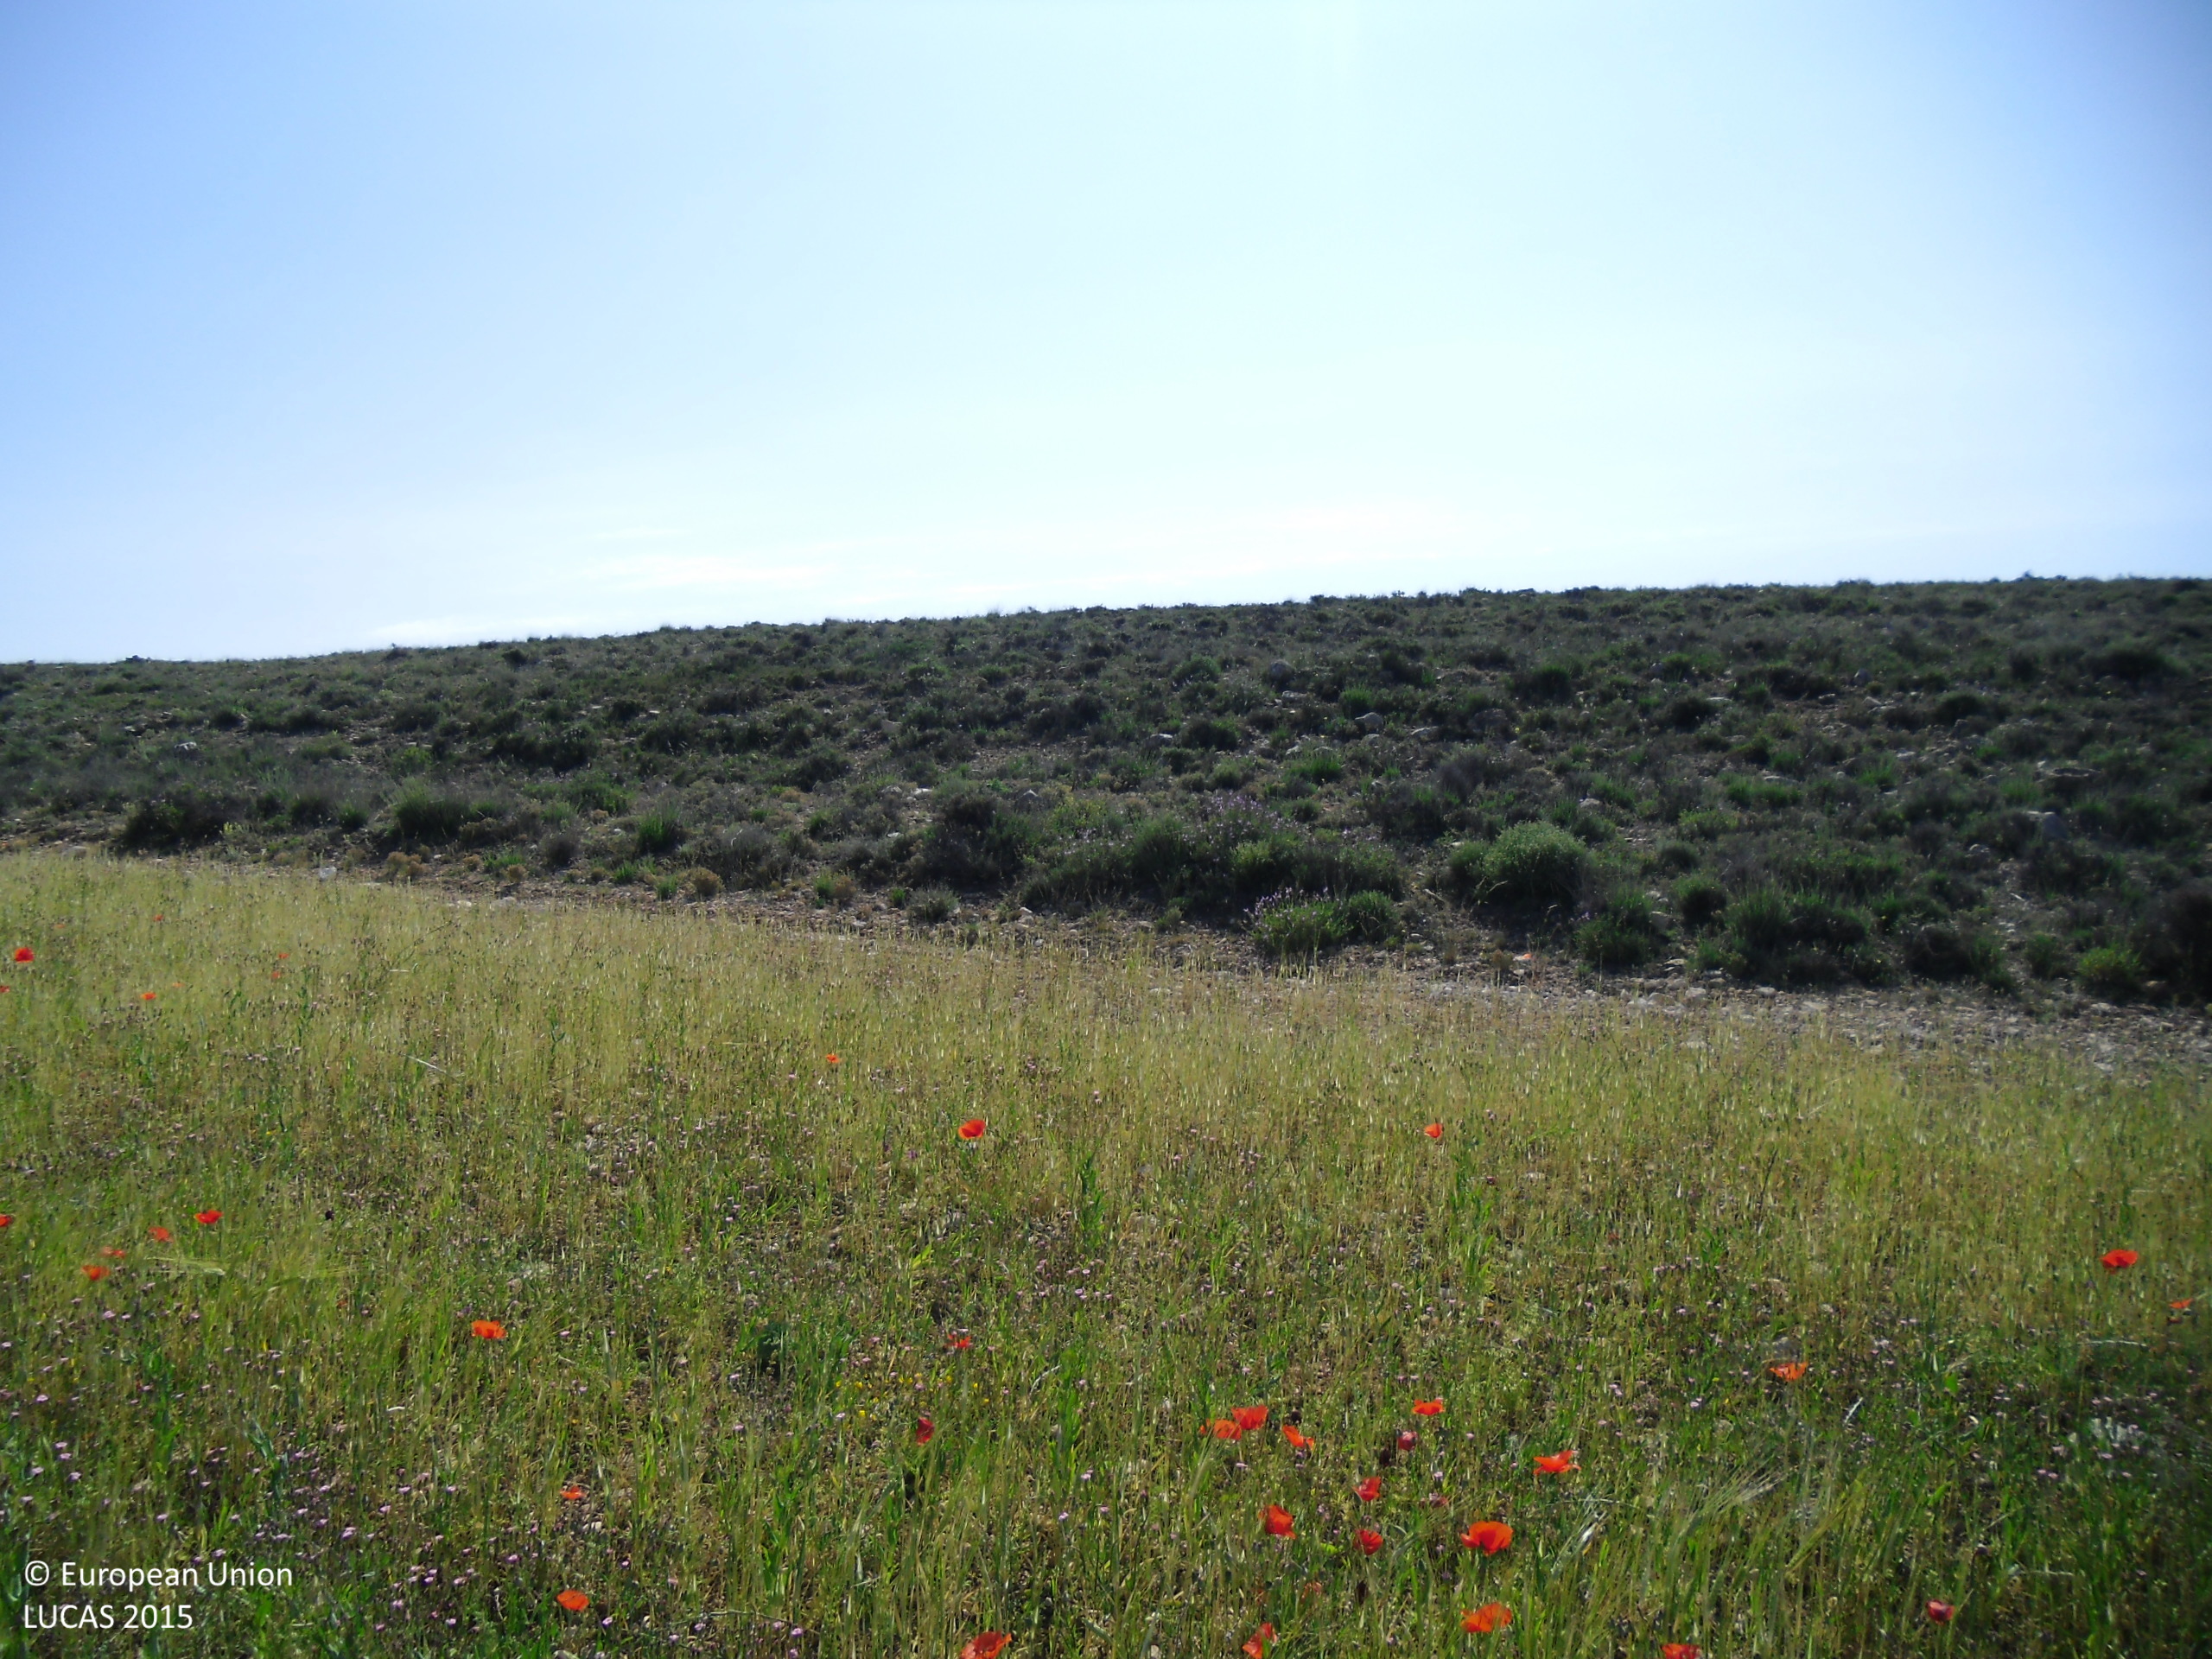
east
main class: Cropland
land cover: Barley
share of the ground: > 75 %
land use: Agriculture (excluding fallow land and kitchen gardens)
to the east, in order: Barley; Shrubland without tree cover; Tracks; Shrubland without tree cover; Tracks; Shrubland without tree cover; Tracks; Shrubland without tree cover
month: June
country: ES
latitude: 41.0669
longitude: -0.6897
